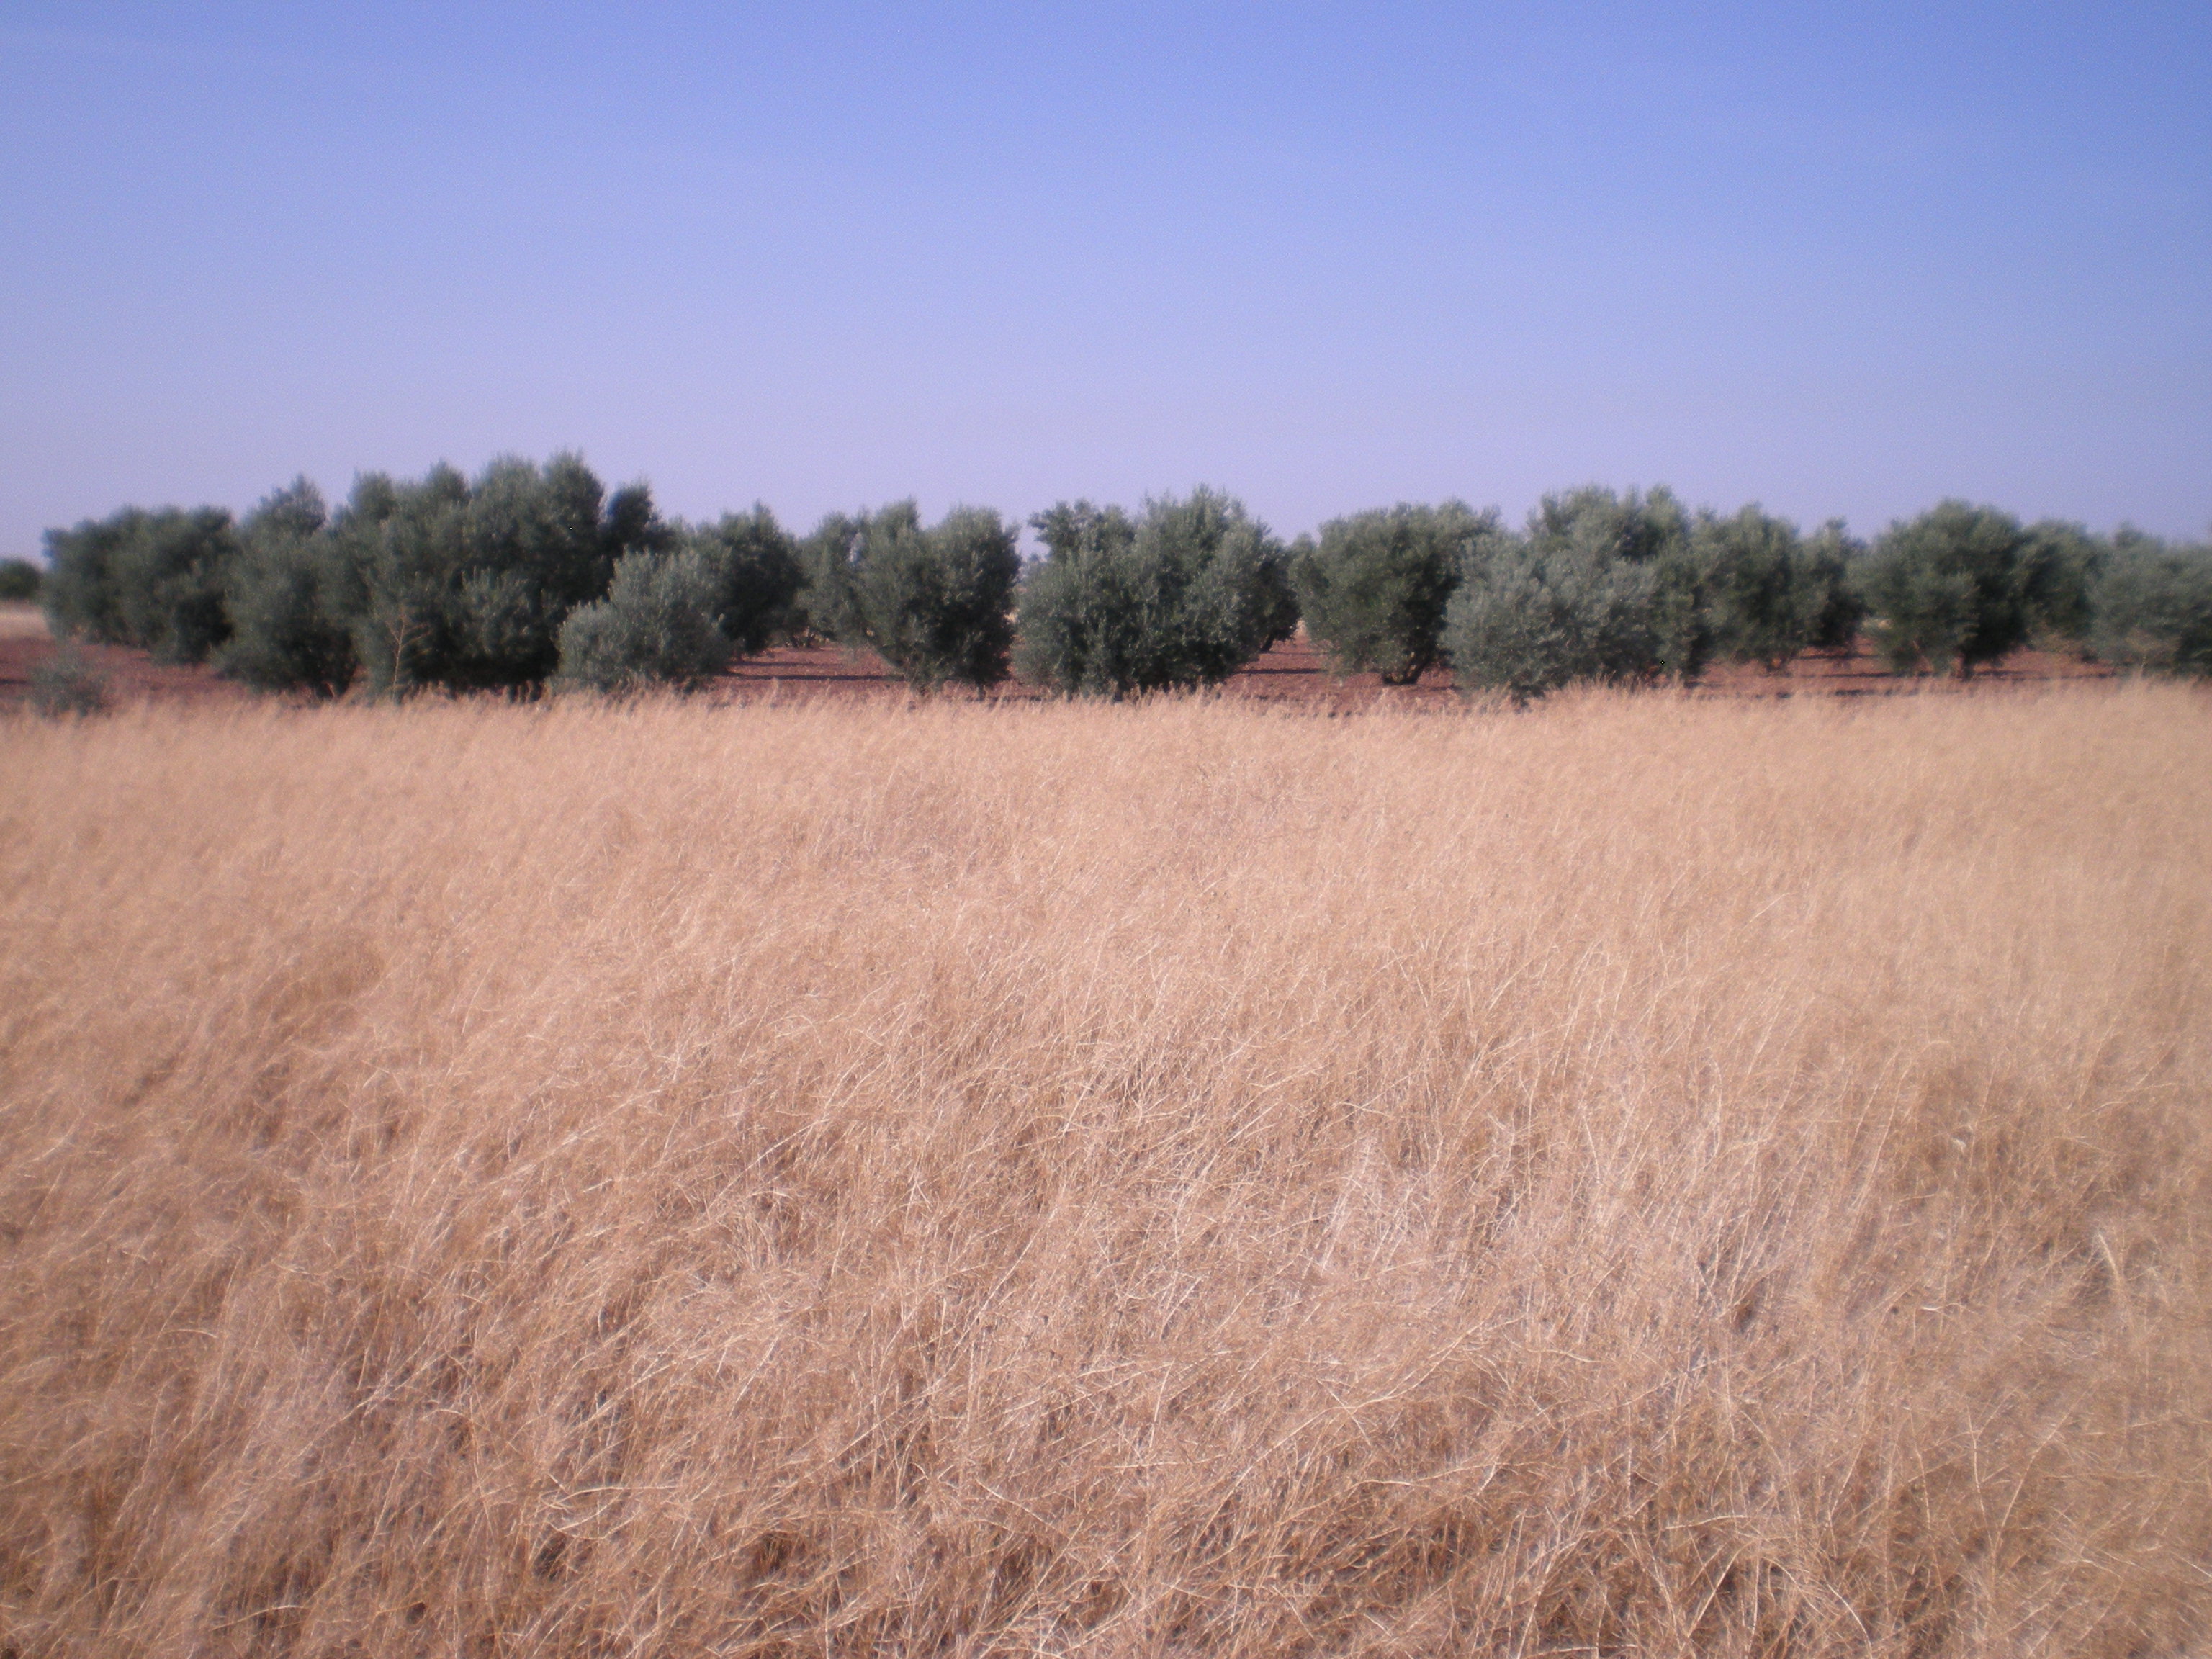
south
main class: Grassland
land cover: Spontaneously vegetated surfaces
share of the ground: 10 - 25 %
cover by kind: unconsolidated bare surface 85 %, herbaceous plants 15 %
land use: Fallow land
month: July
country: ES
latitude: 39.4087
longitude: -3.0588
